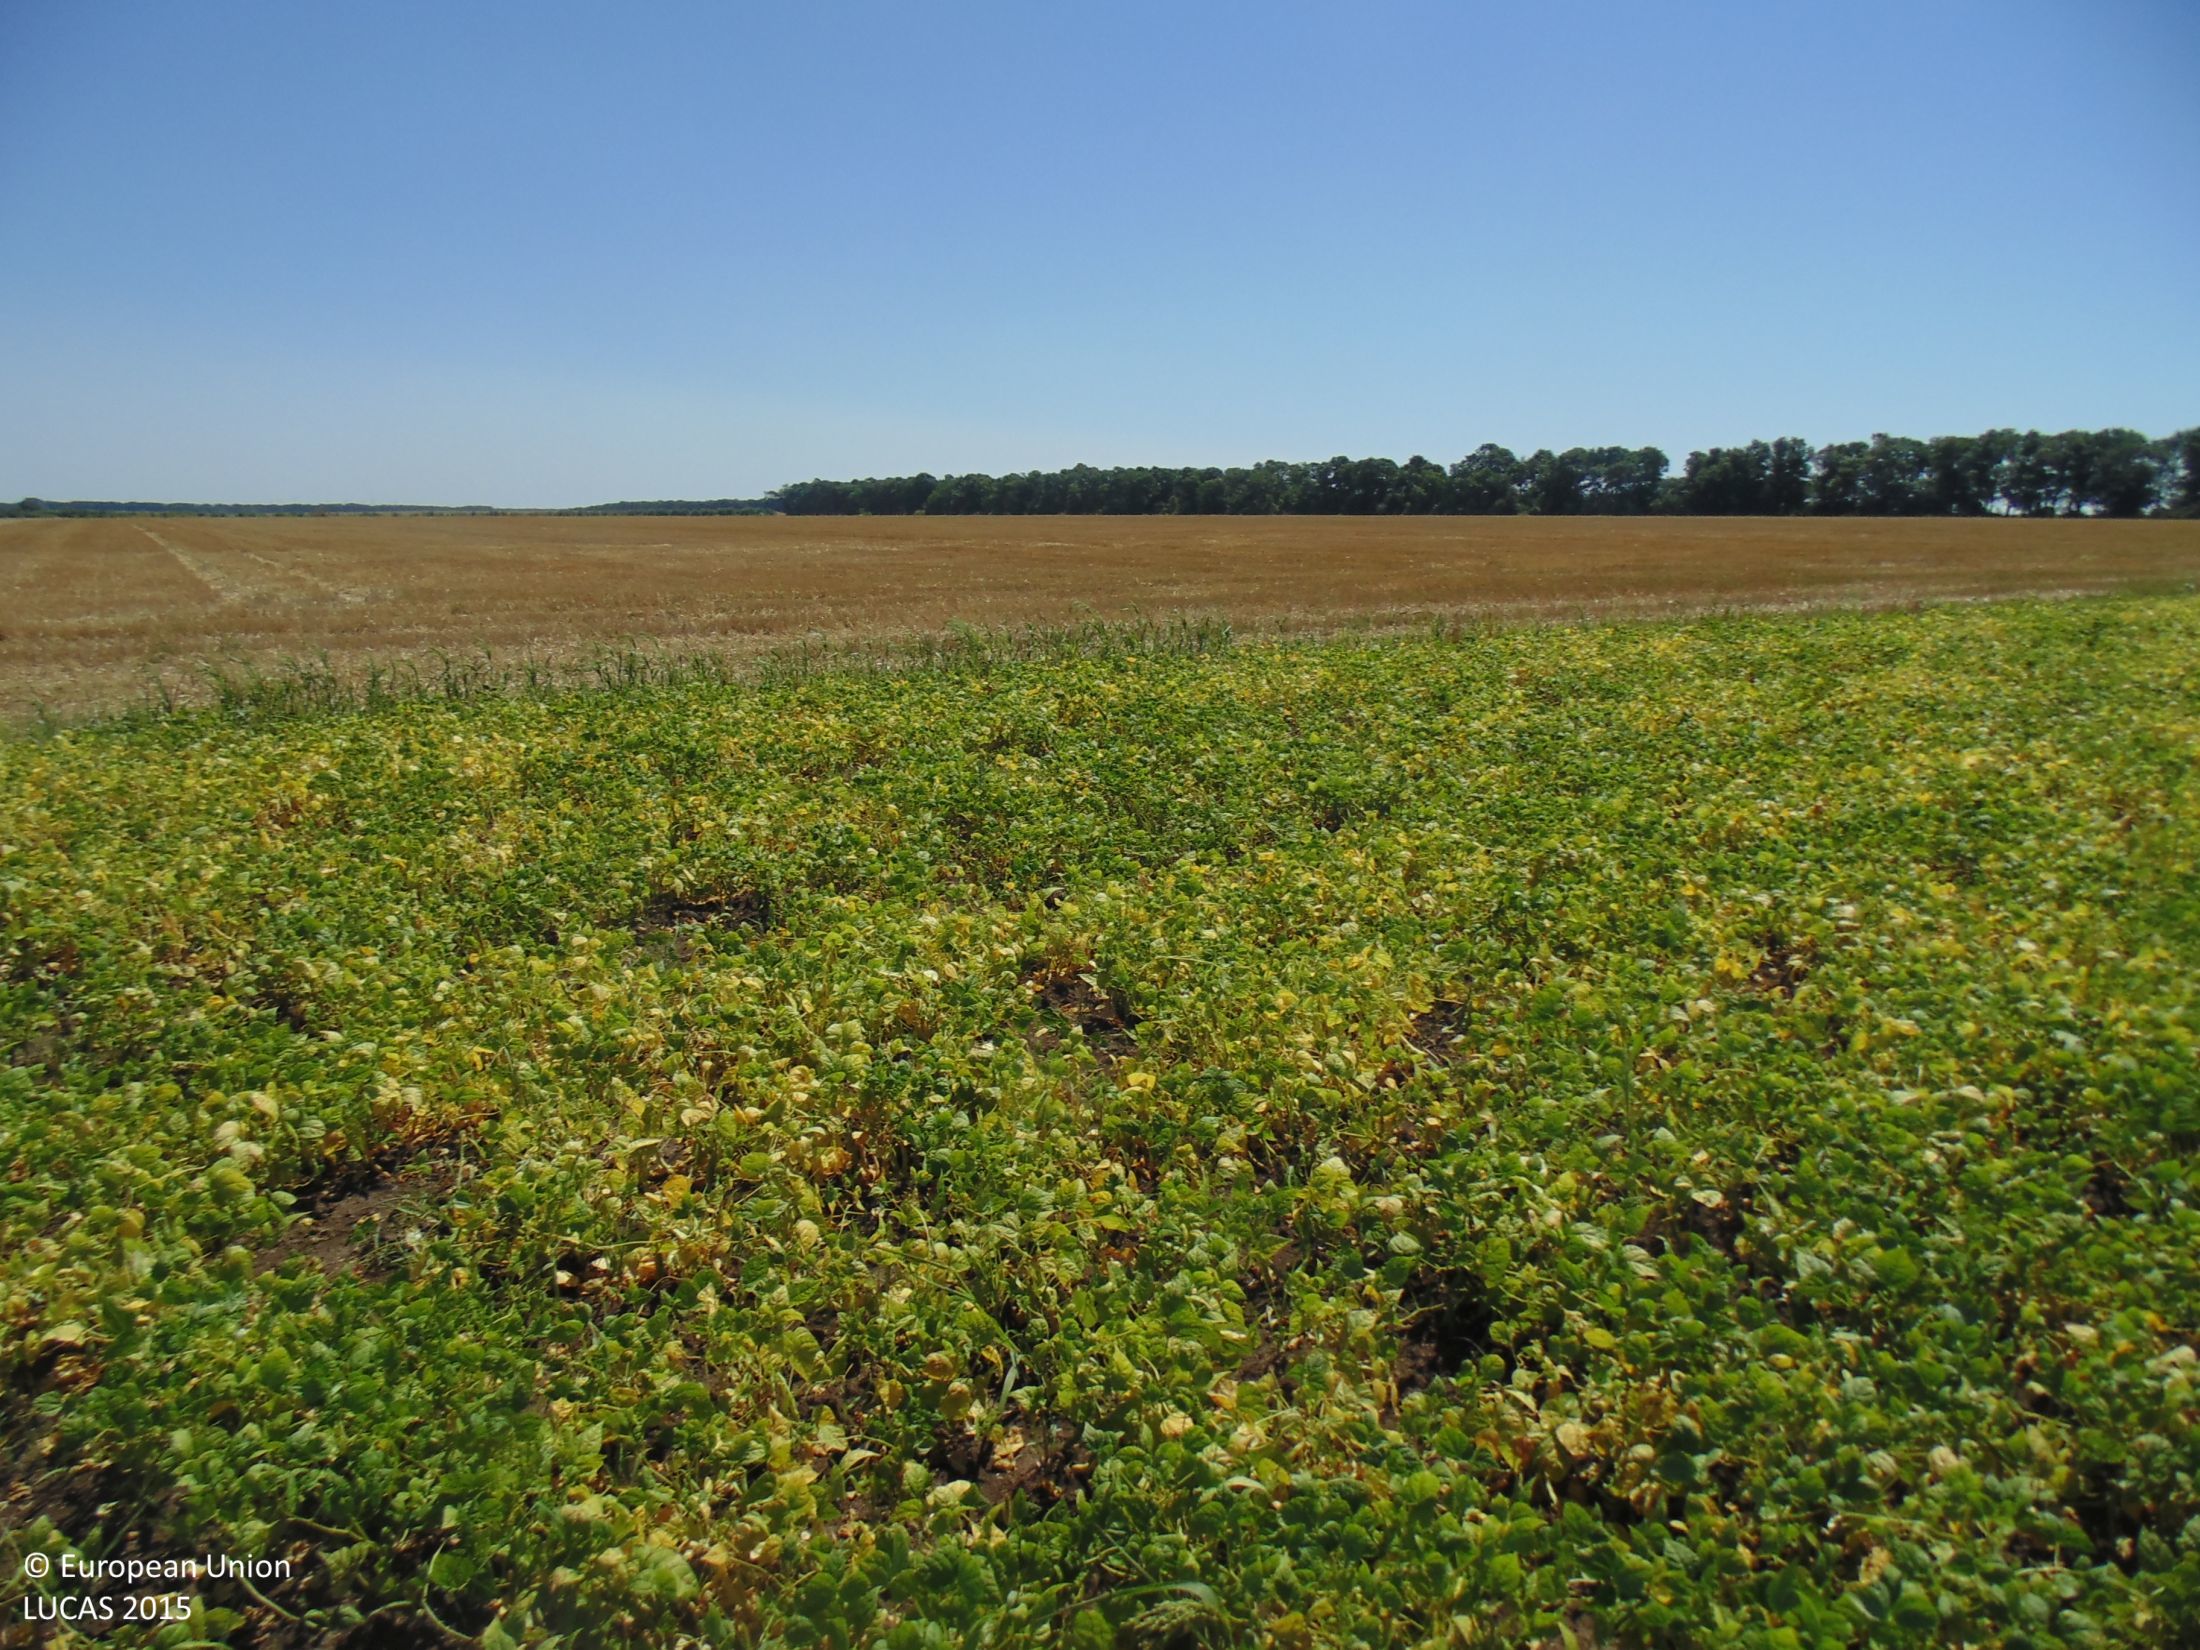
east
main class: Cropland
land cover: Dry pulses
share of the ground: > 75 %
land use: Agriculture (excluding fallow land and kitchen gardens)
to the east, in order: Dry pulses; Grass margins; Common wheat
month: July
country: BG
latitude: 43.4565
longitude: 28.1307
